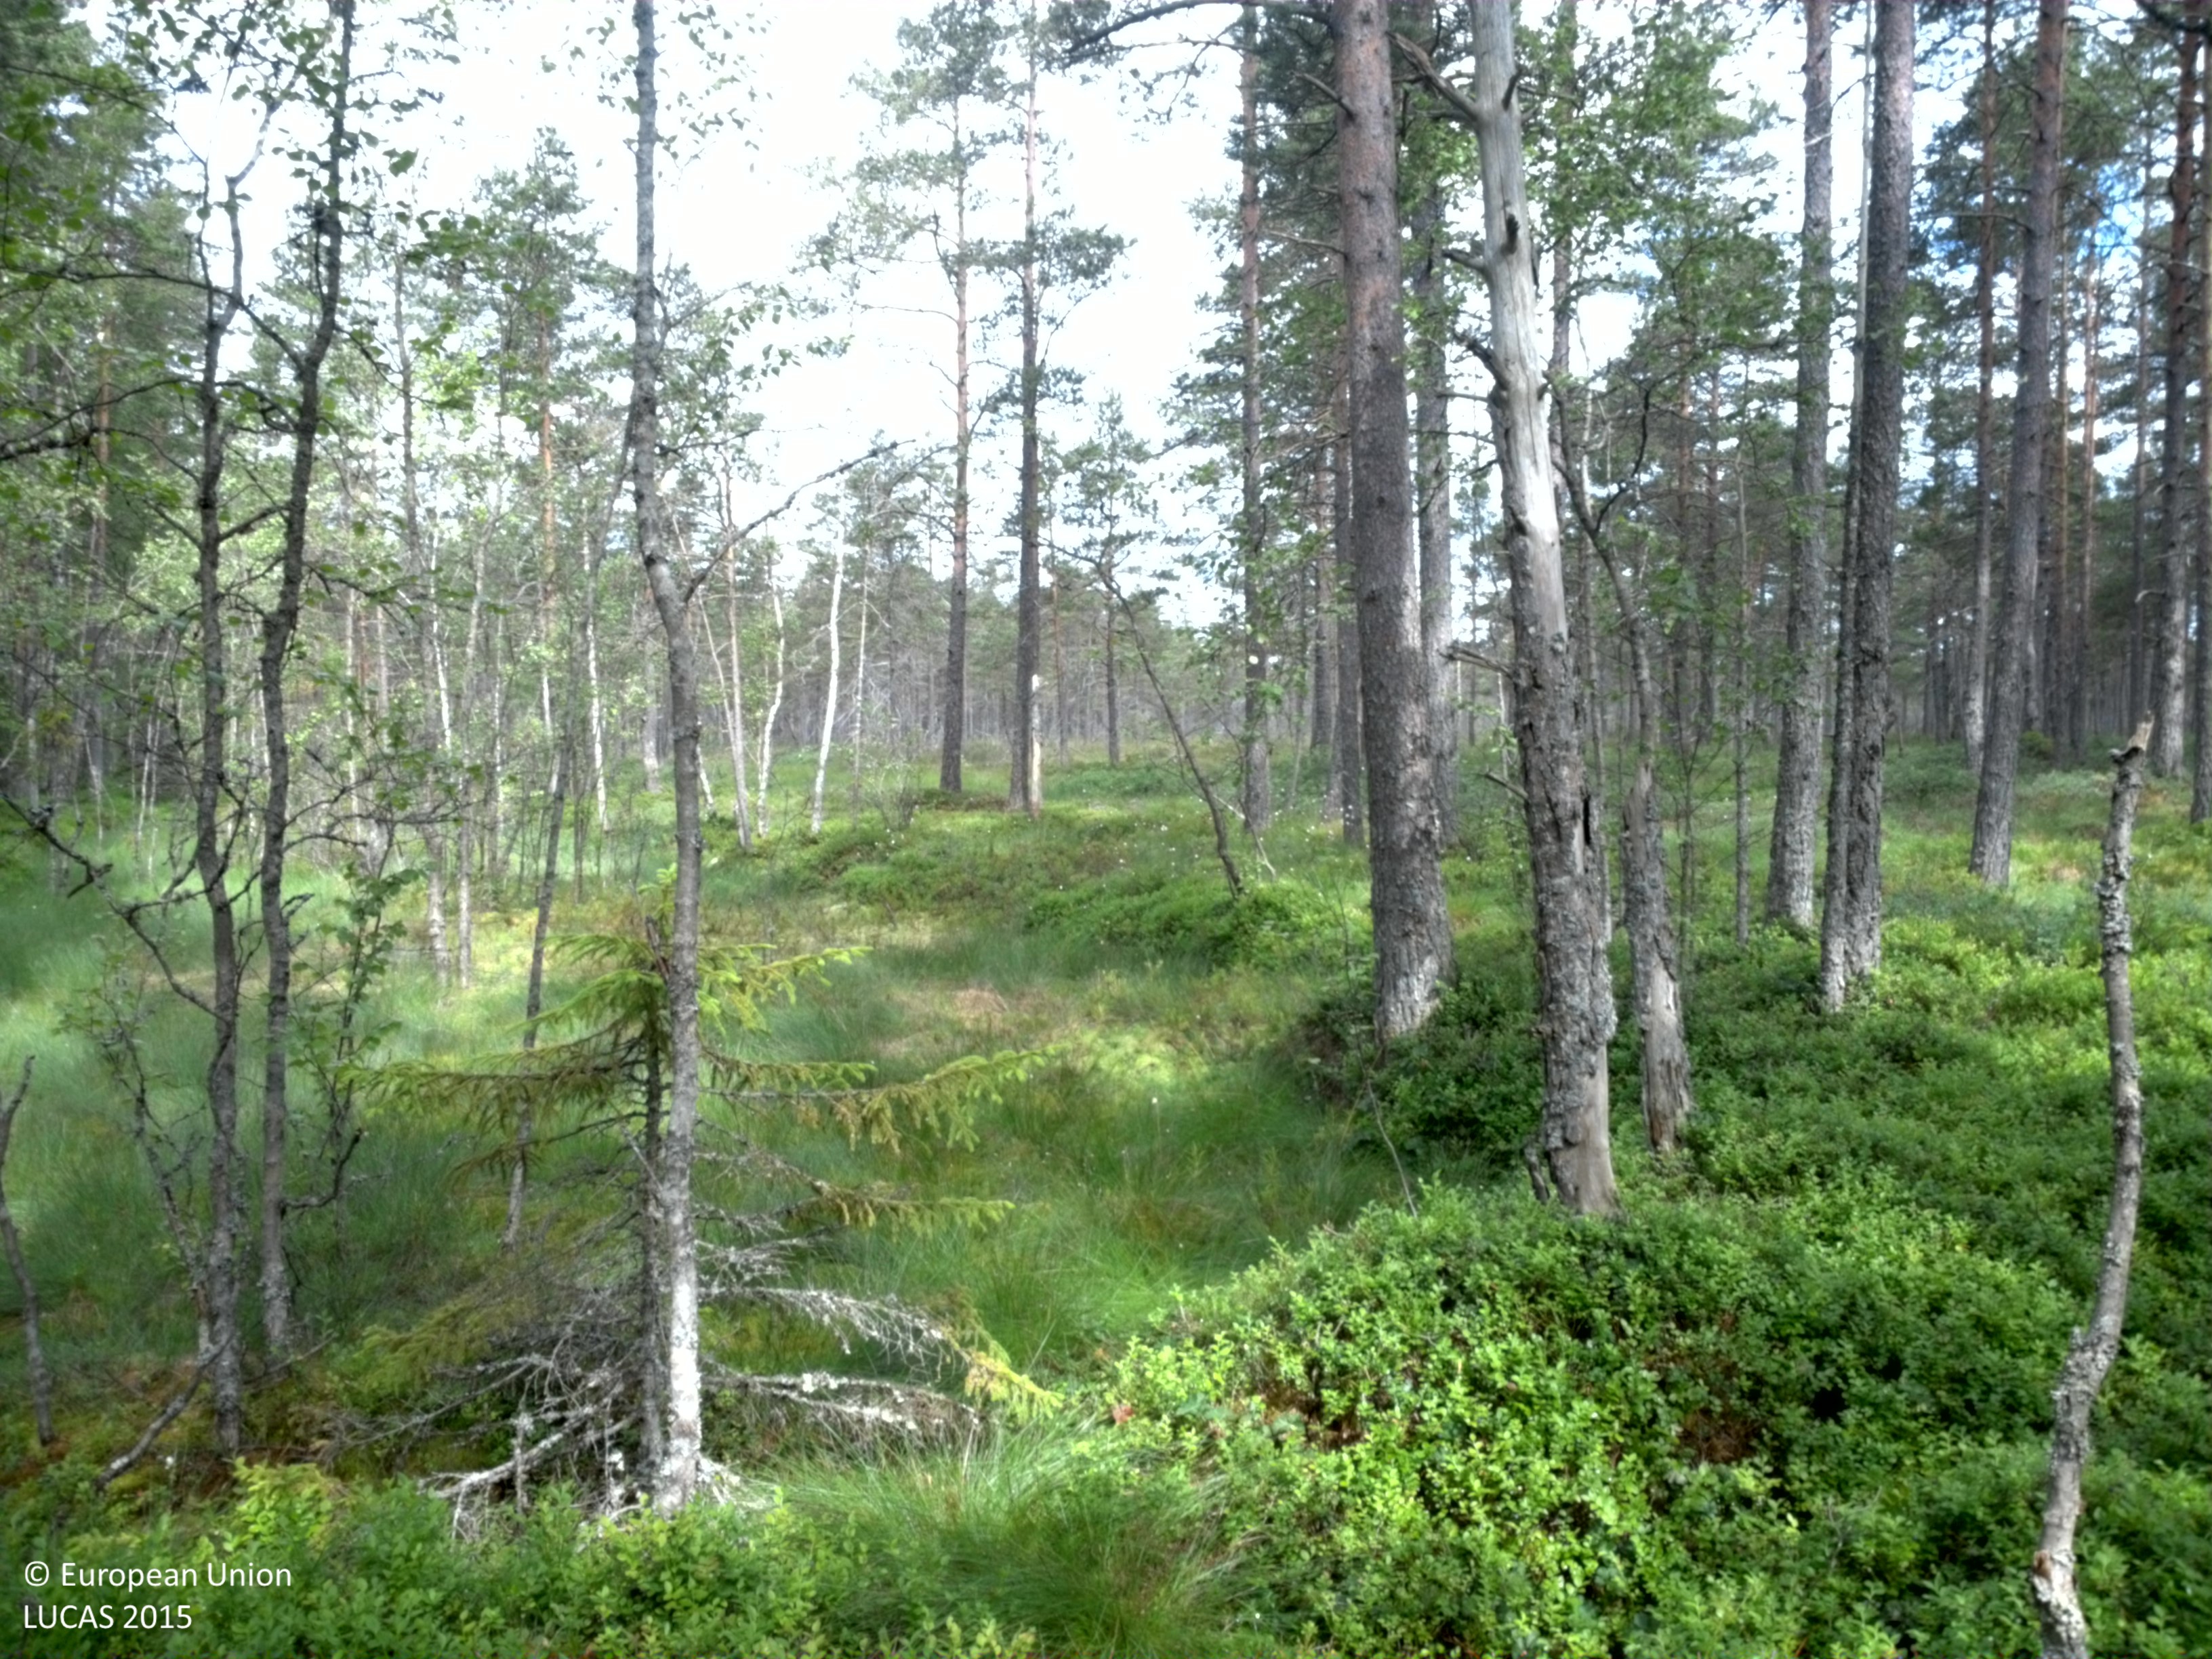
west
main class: Woodland
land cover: Pine dominated coniferous woodland
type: boreal forest
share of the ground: 50 - 75 %
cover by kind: coniferous forest trees 70 %, lichens and mosses 30 %
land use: Forestry
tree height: > 5 m
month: July
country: SE
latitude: 57.6363
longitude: 14.6016
